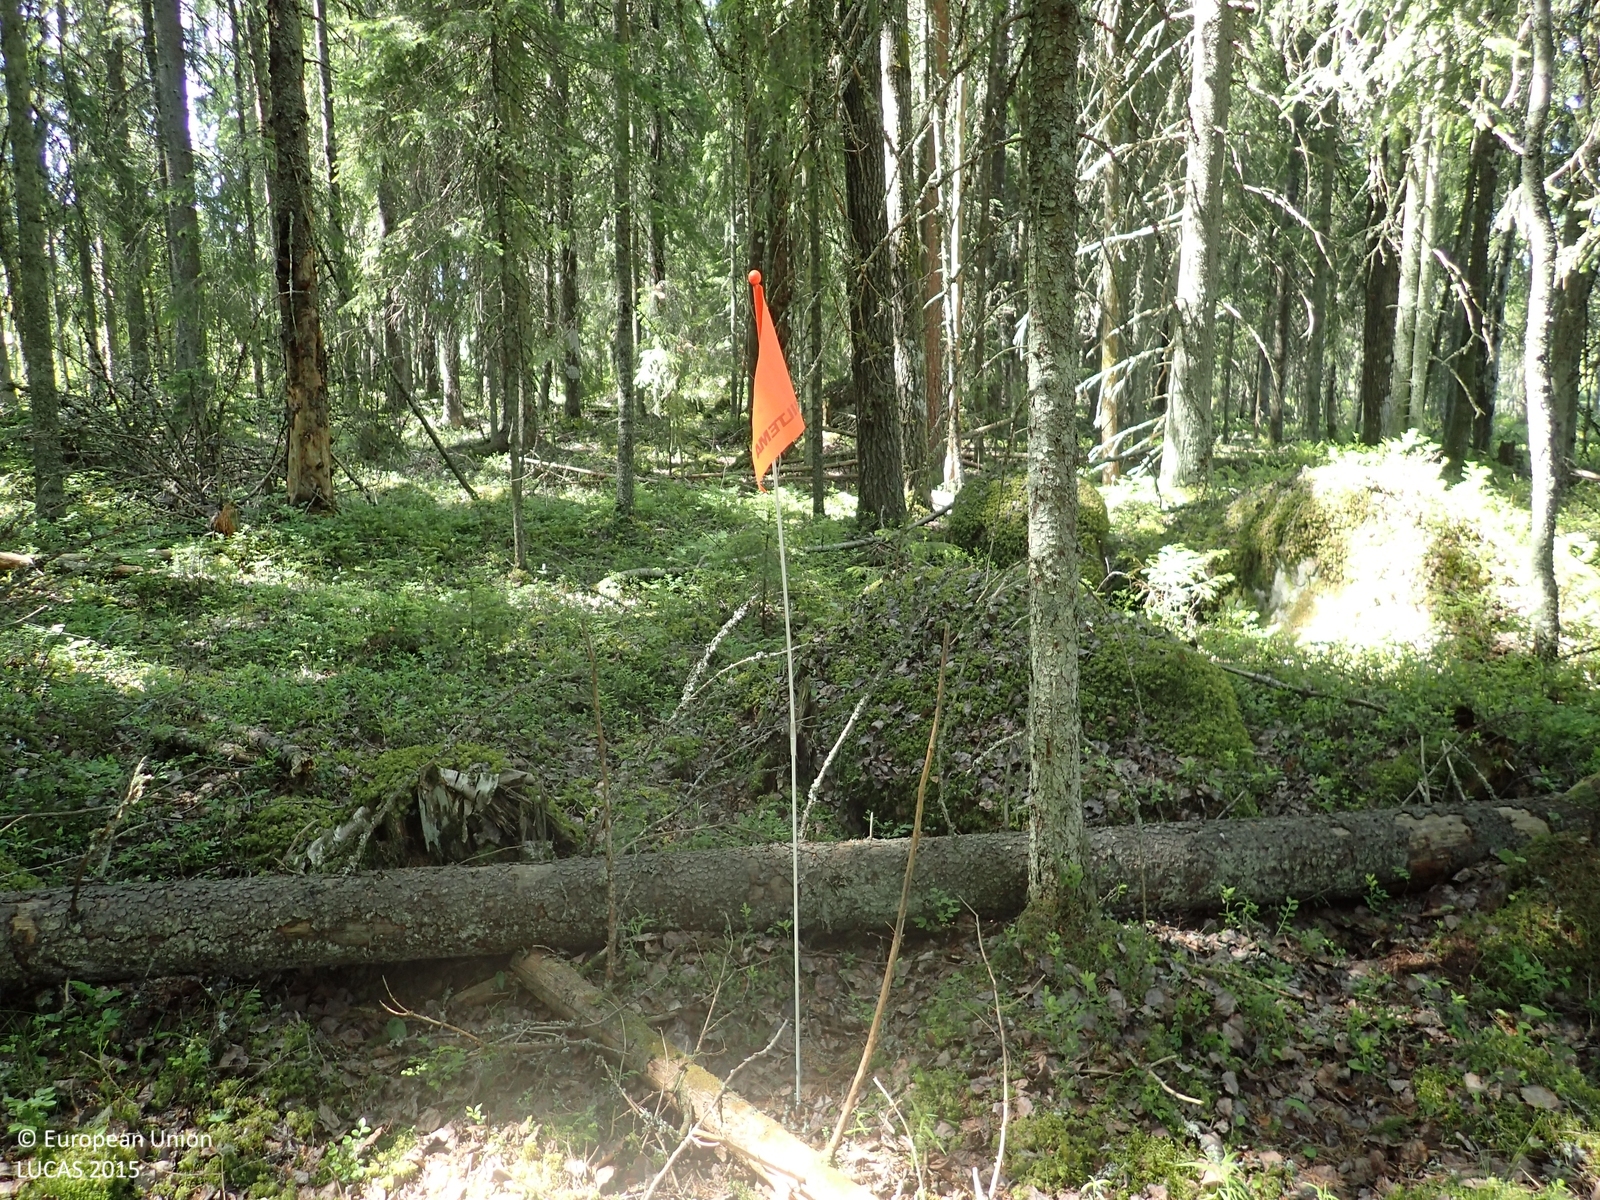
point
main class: Woodland
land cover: Spruce dominated mixed woodland
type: boreal forest
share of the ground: > 75 %
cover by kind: coniferous forest trees 60 %, broadleaved forest trees 20 %, shrubs 15 %, lichens and mosses 5 %
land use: Forestry
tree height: > 5 m
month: July
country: FI
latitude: 62.5509
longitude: 21.5358
